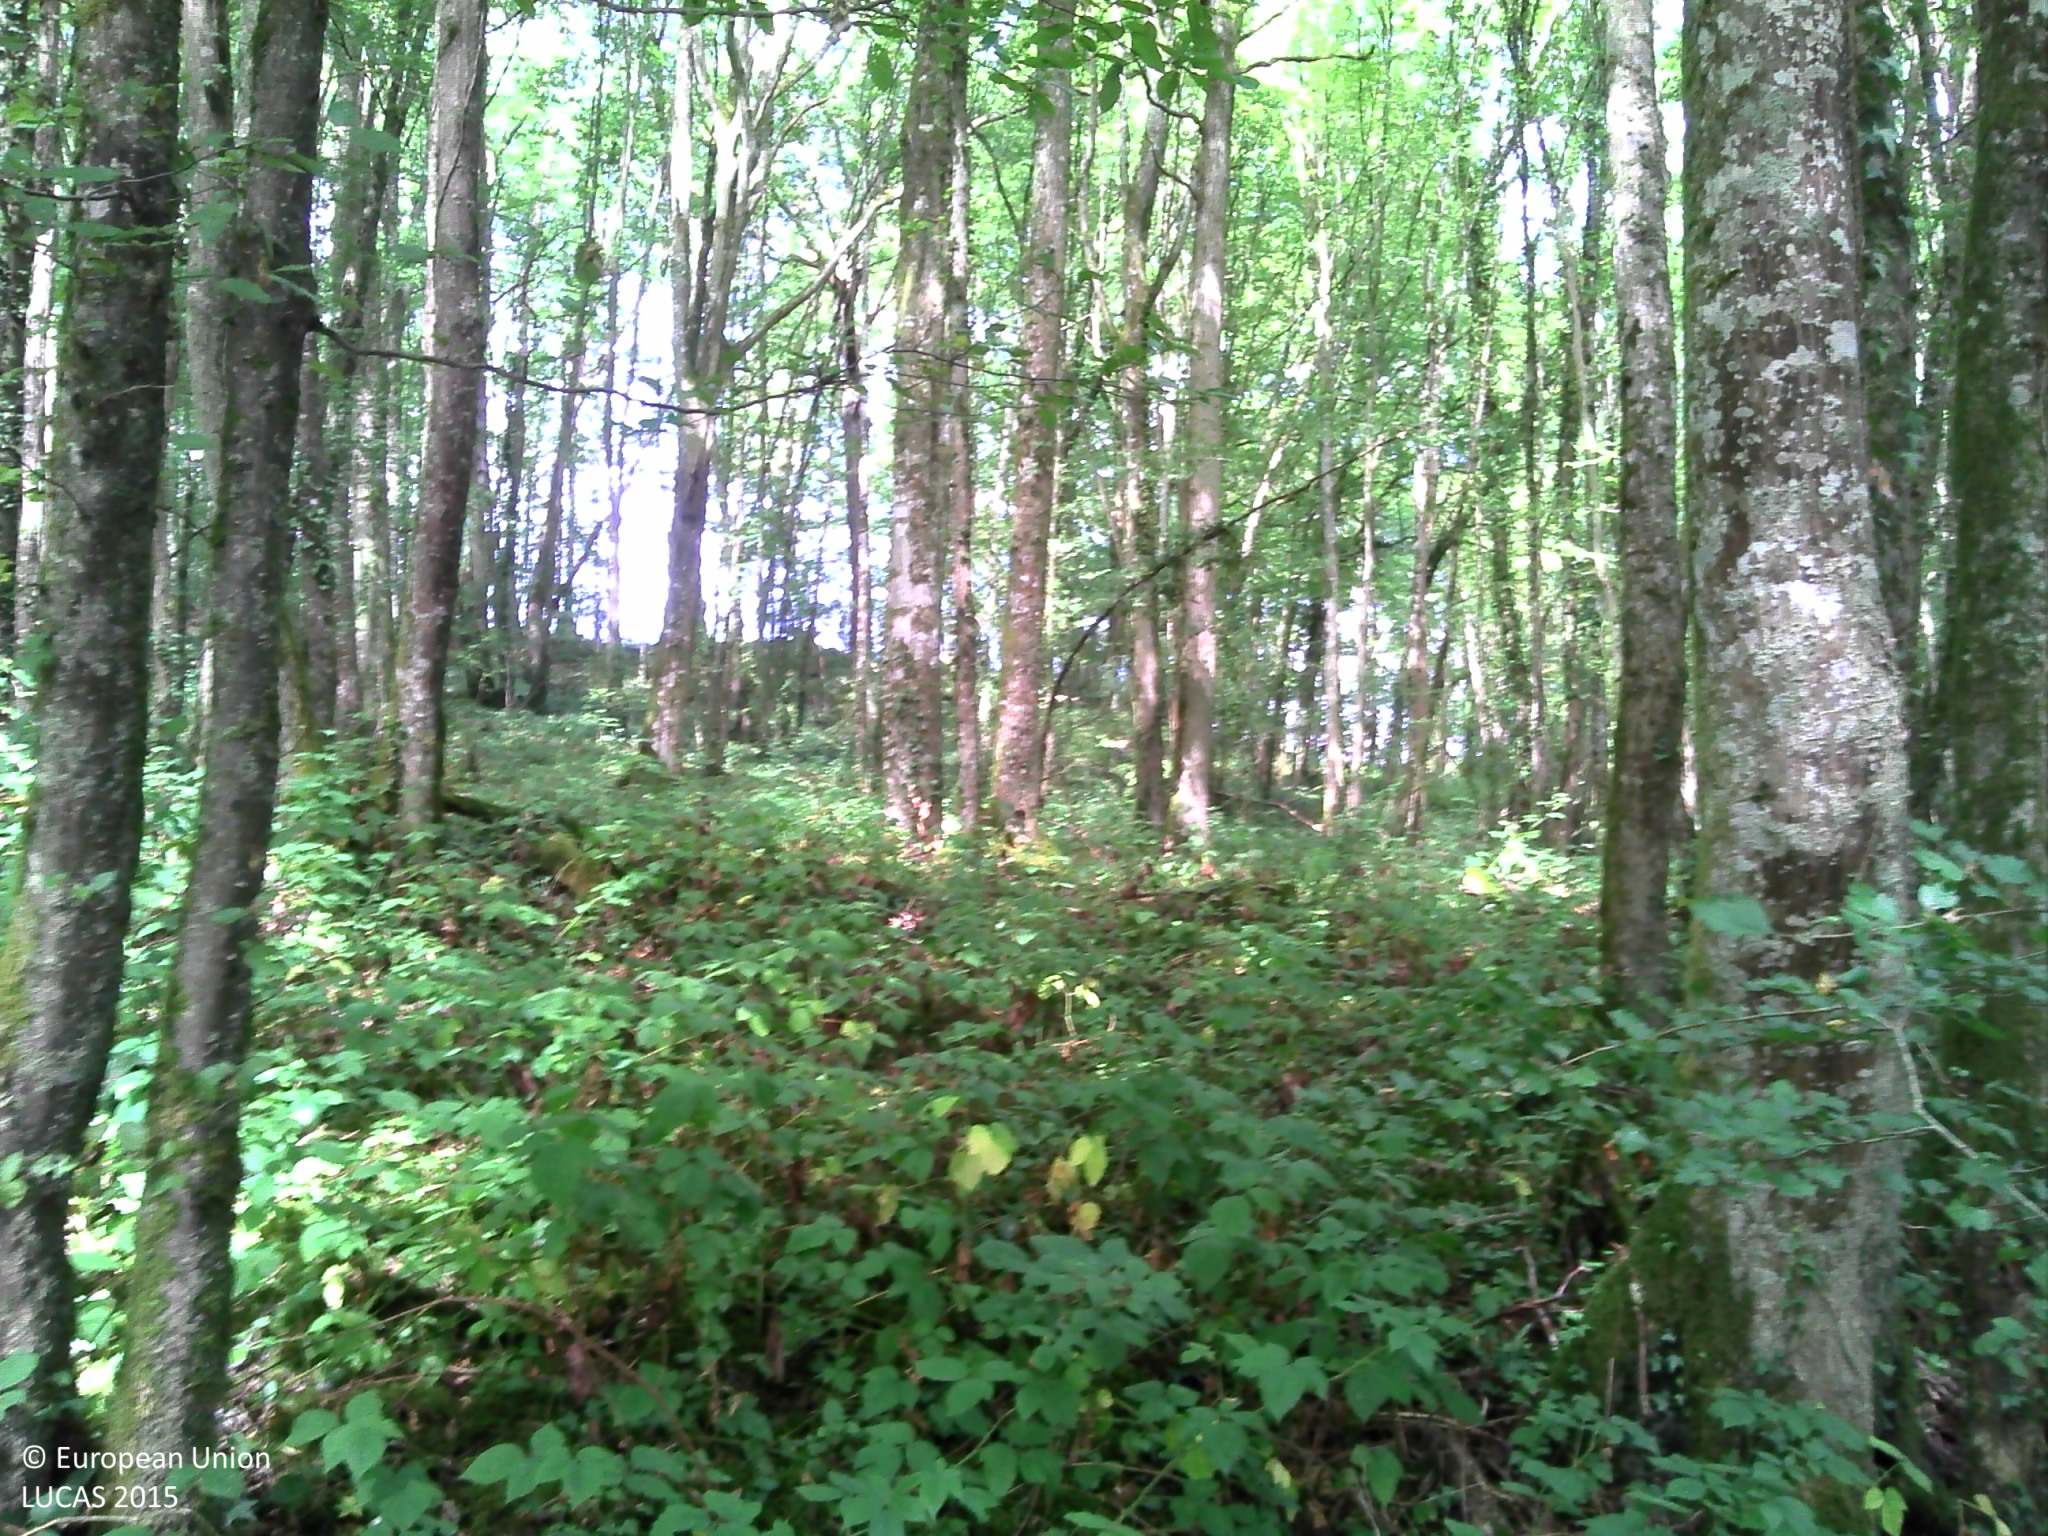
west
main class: Woodland
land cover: Broadleaved woodland
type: mesophytic deciduous forest
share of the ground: > 75 %
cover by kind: broadleaved forest trees 90 %, herbaceous plants 5 %, lichens and mosses 5 %
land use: Forestry
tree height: > 5 m
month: July
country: FR
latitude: 47.9154
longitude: 3.0756
